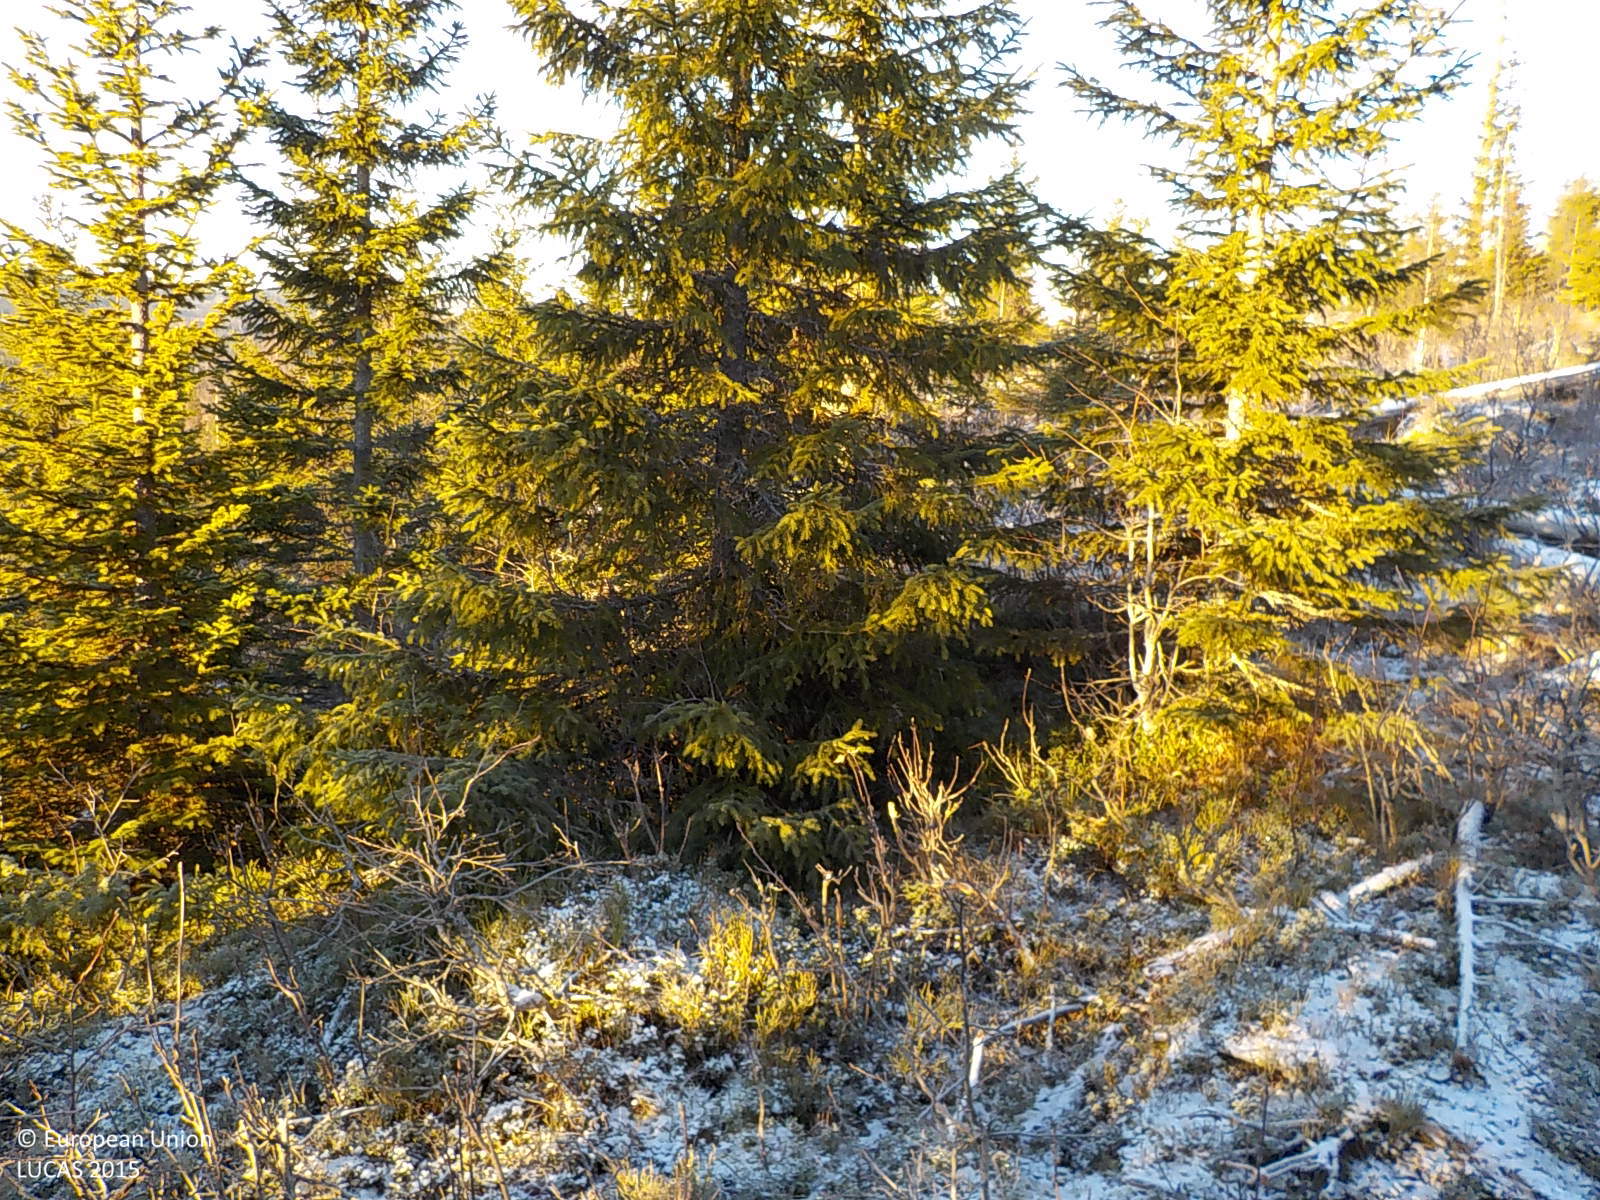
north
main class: Woodland
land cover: Spruce dominated coniferous woodland
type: boreal forest
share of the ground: 50 - 75 %
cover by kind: coniferous forest trees 60 %, shrubs 20 %, herbaceous plants 20 %
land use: Forestry
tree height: < 5 m
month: November
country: SE
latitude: 63.1280
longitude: 18.2870
